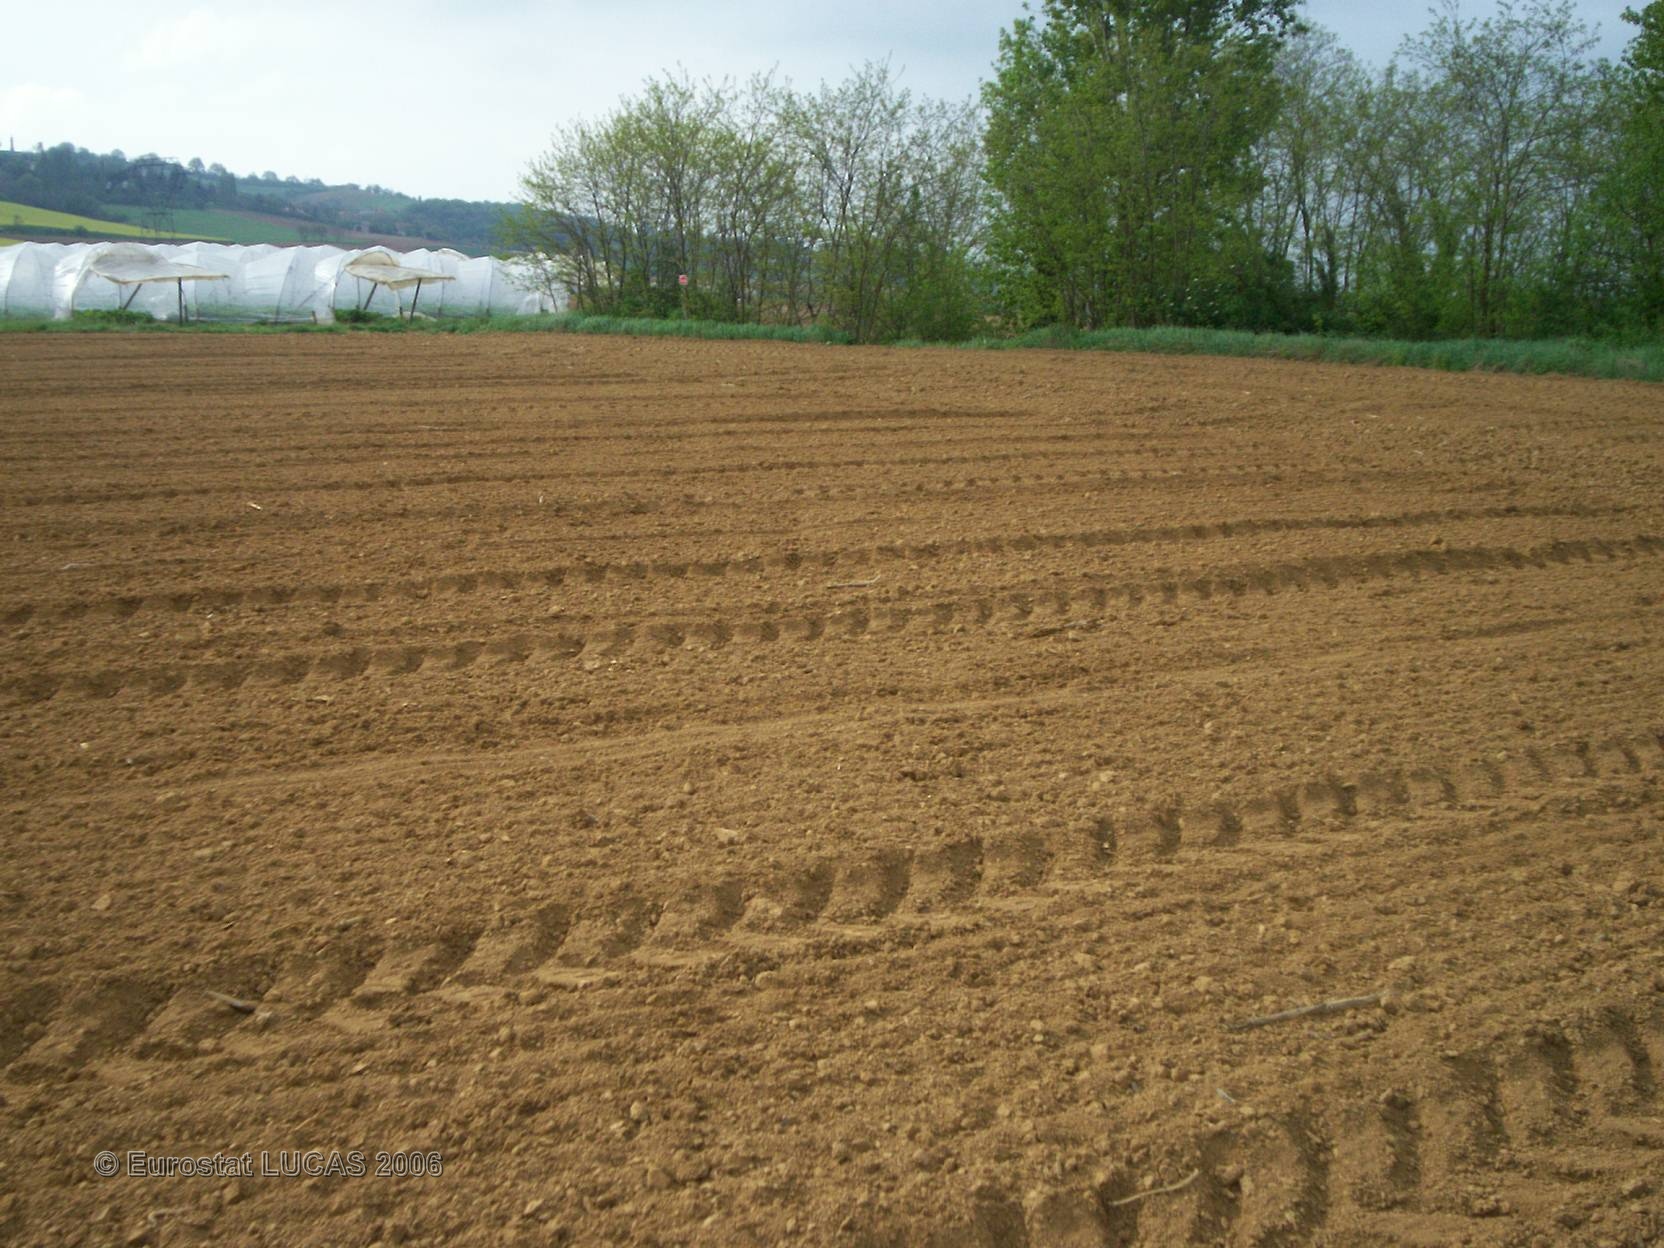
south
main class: Cropland
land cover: Maize
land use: Agriculture (excluding fallow land and kitchen gardens)
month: June
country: FR
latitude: 45.3791
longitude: 4.8581
